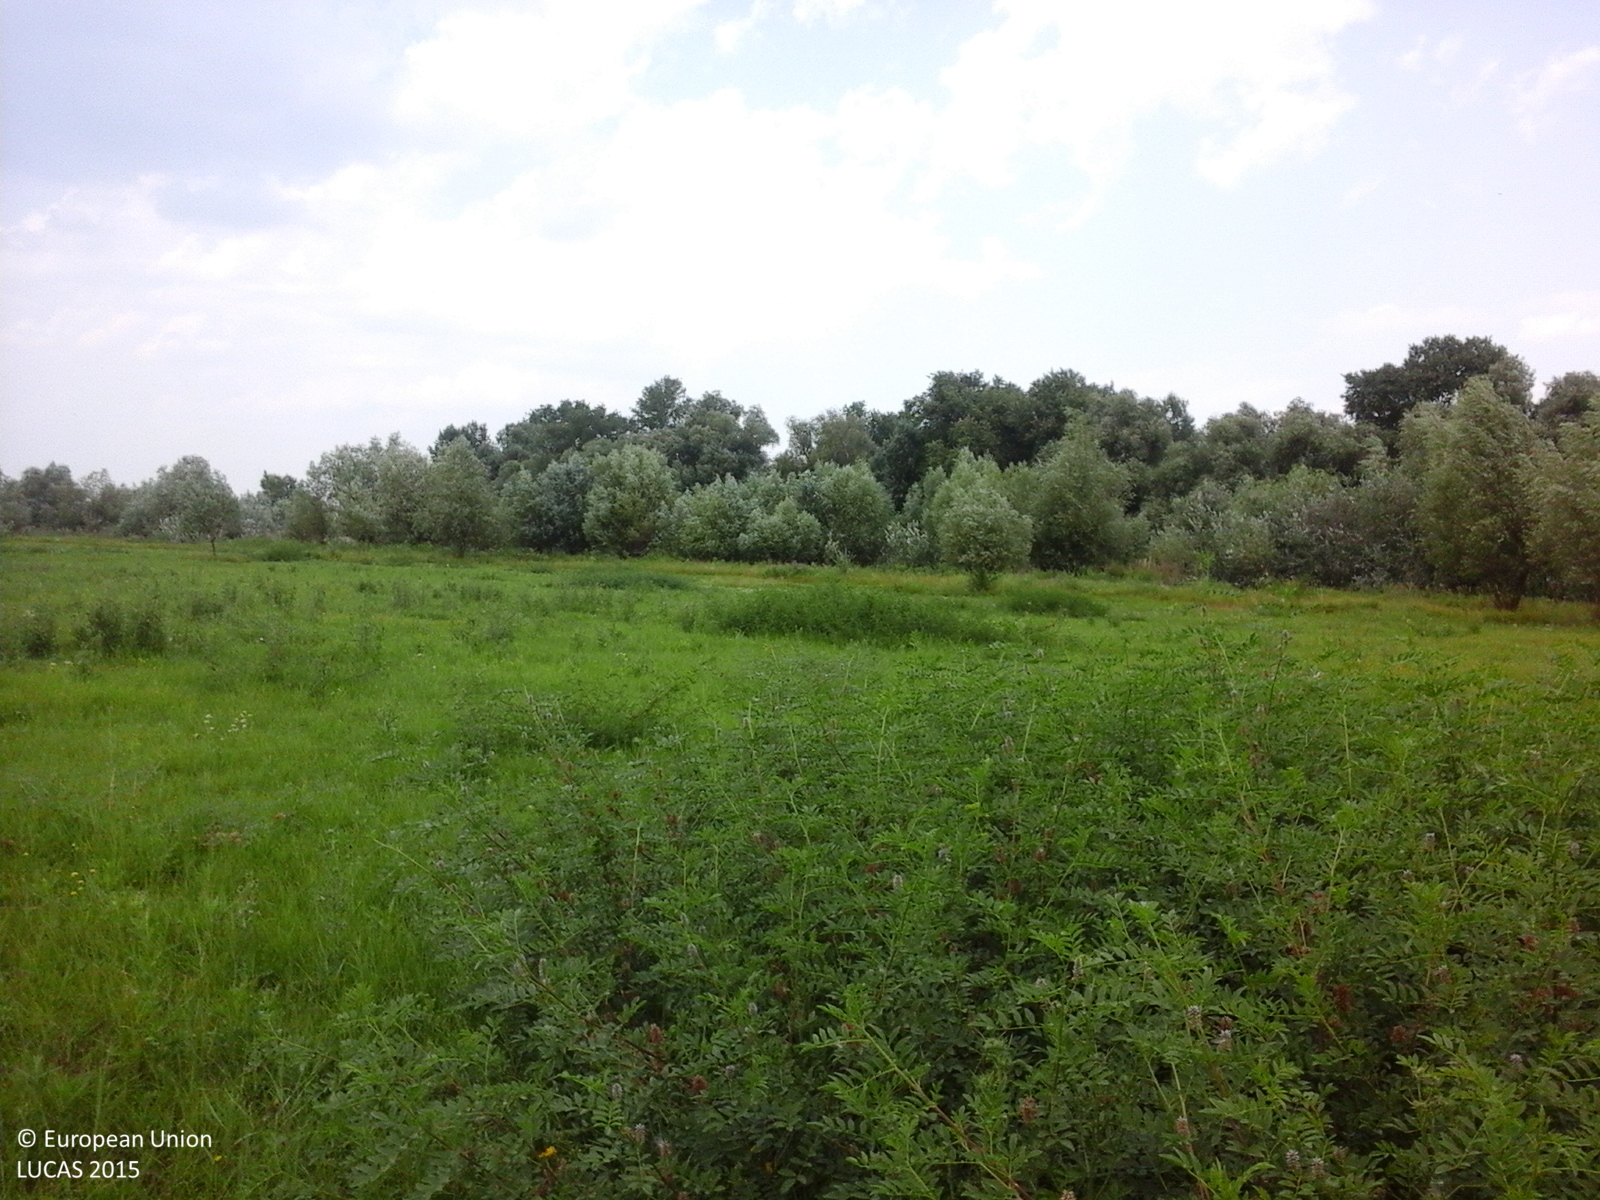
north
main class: Grassland
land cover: Spontaneously vegetated surfaces
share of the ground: > 75 %
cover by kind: herbaceous plants 100 %
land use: Agriculture (excluding fallow land and kitchen gardens)
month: July
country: RO
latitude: 46.0441
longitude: 28.1013
